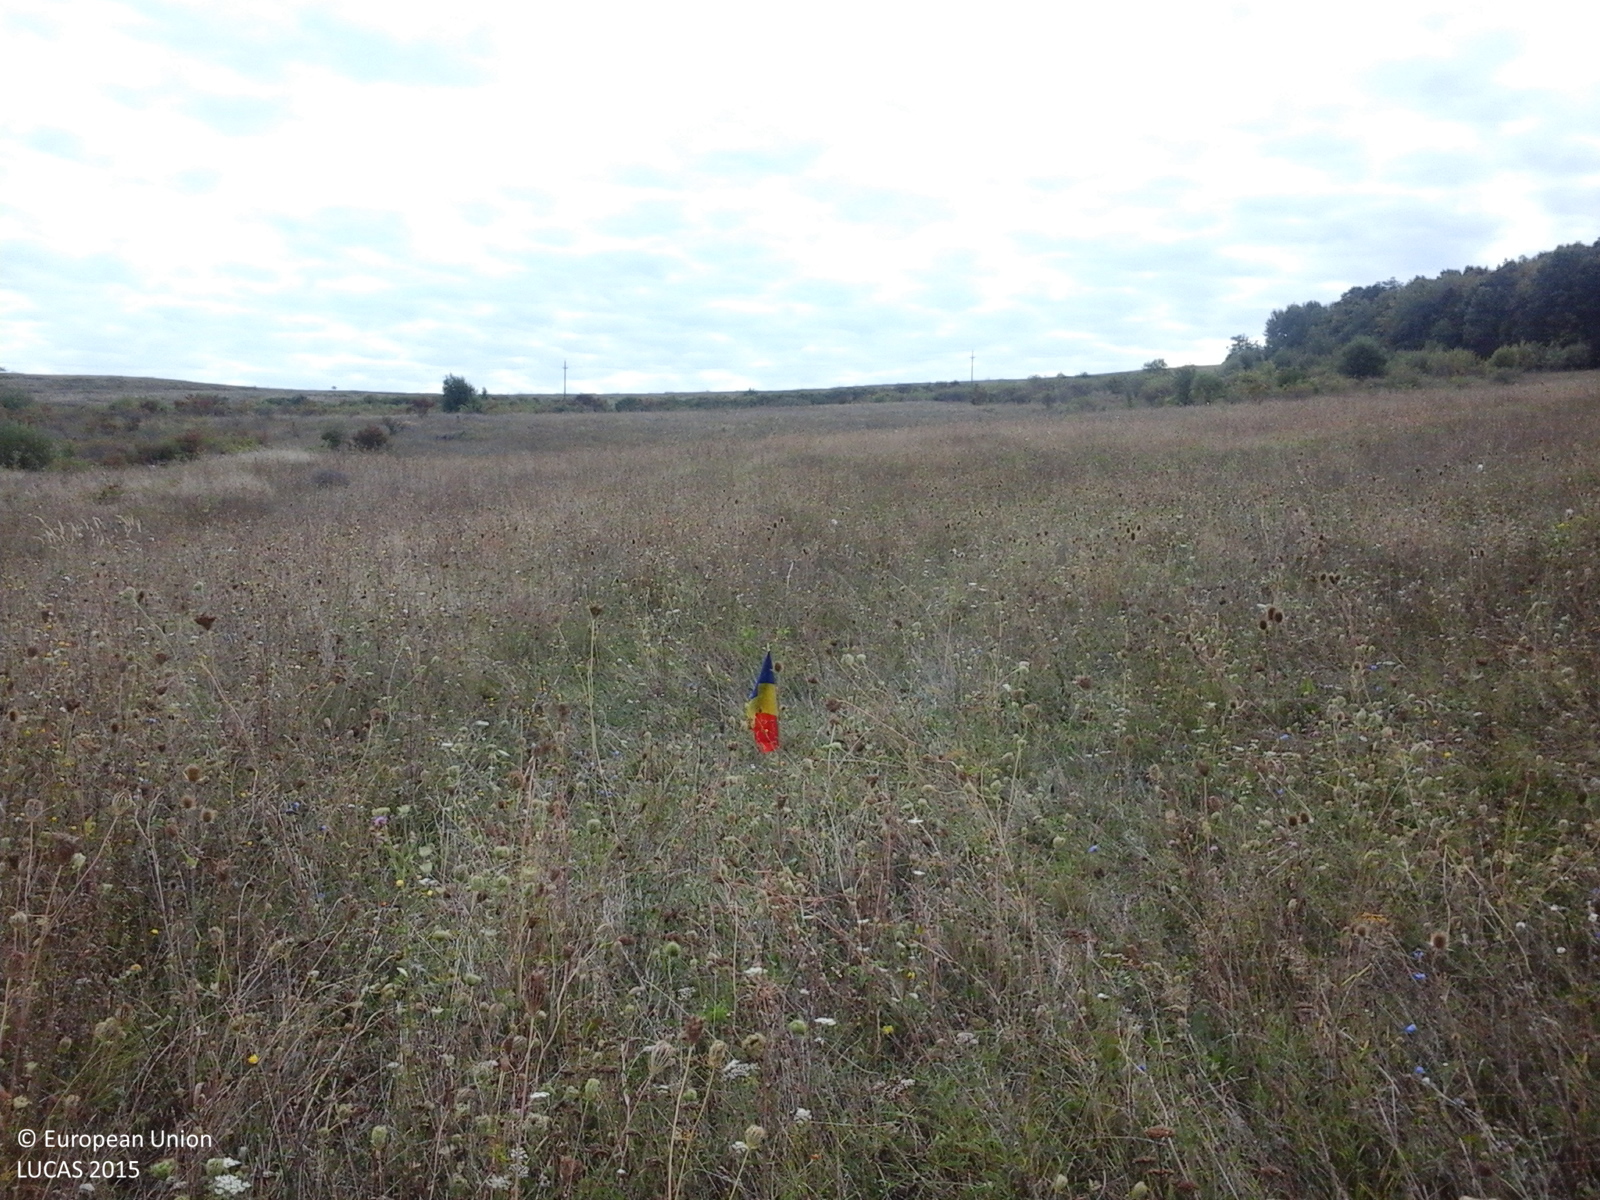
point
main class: Grassland
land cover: Grassland without tree/shrub cover
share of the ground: > 75 %
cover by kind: herbaceous plants 100 %
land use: Agriculture (excluding fallow land and kitchen gardens)
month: September
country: RO
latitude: 47.4008
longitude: 23.2529
